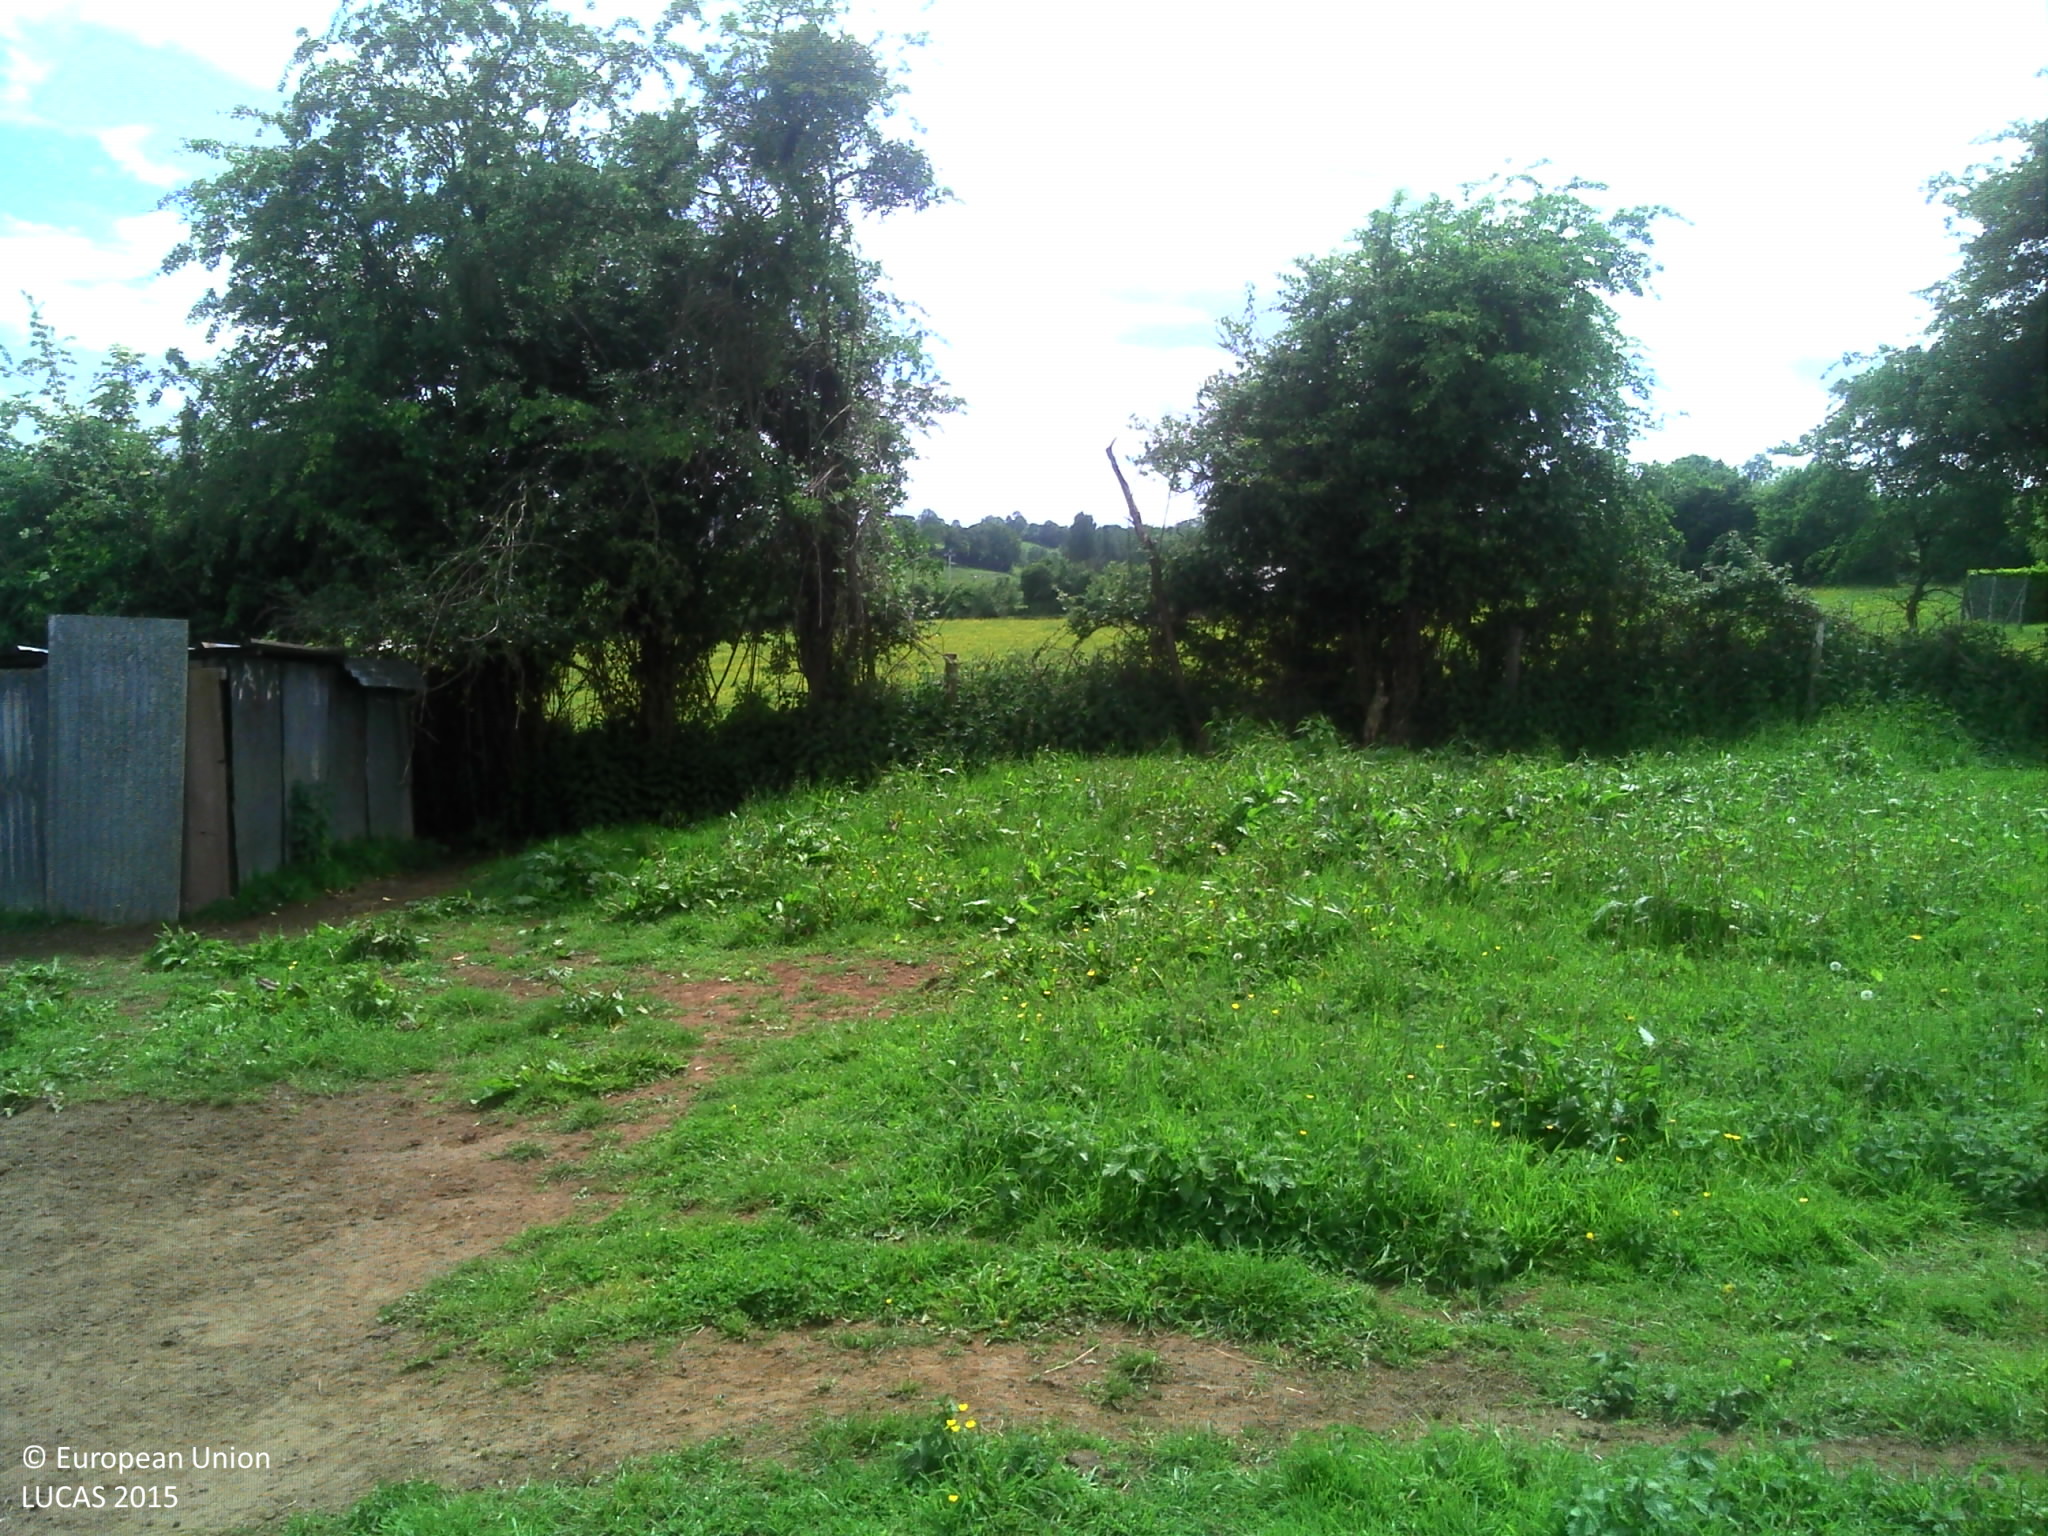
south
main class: Grassland
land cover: Grassland without tree/shrub cover
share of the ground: > 75 %
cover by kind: herbaceous plants 95 %
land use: Agriculture (excluding fallow land and kitchen gardens)
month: June
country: FR
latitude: 48.9191
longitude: 0.1039
